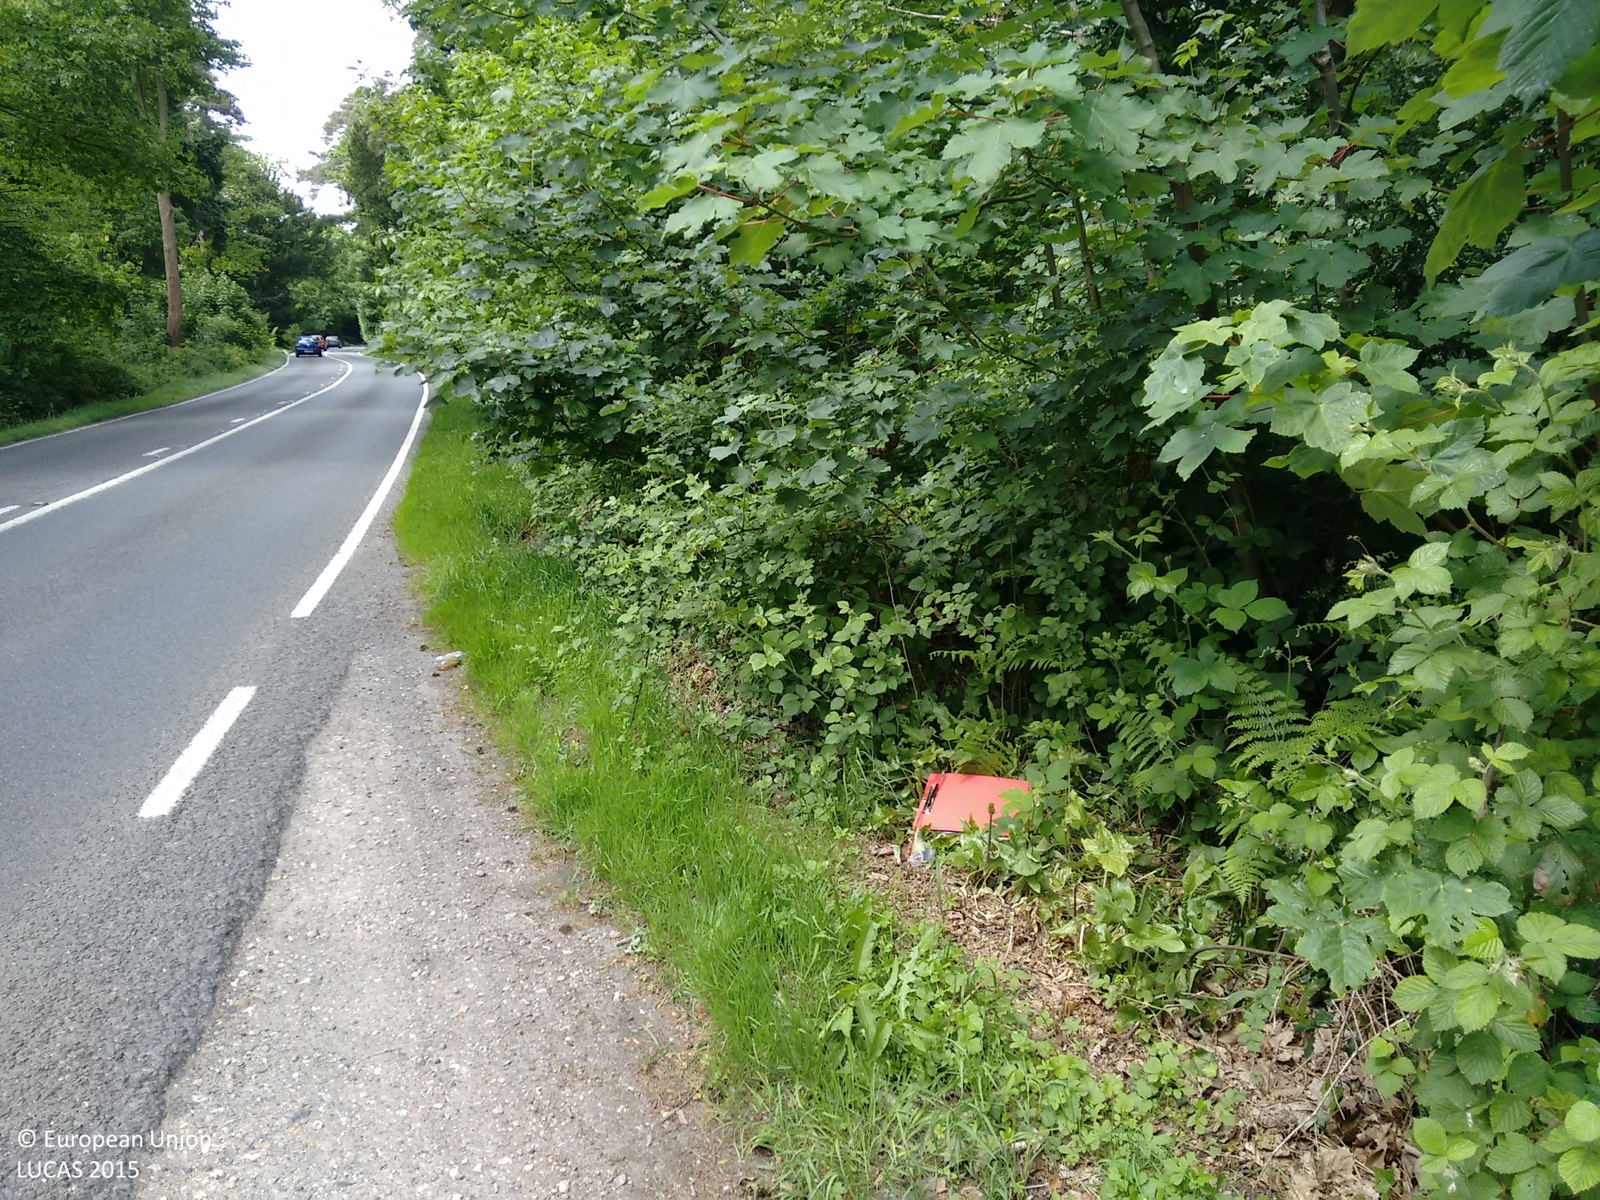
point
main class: Woodland
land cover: Broadleaved woodland
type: mesophytic deciduous forest
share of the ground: > 75 %
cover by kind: broadleaved forest trees 90 %, coniferous forest trees 10 %
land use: Forestry
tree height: > 5 m
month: May
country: GB
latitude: 50.8718
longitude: -0.9430
